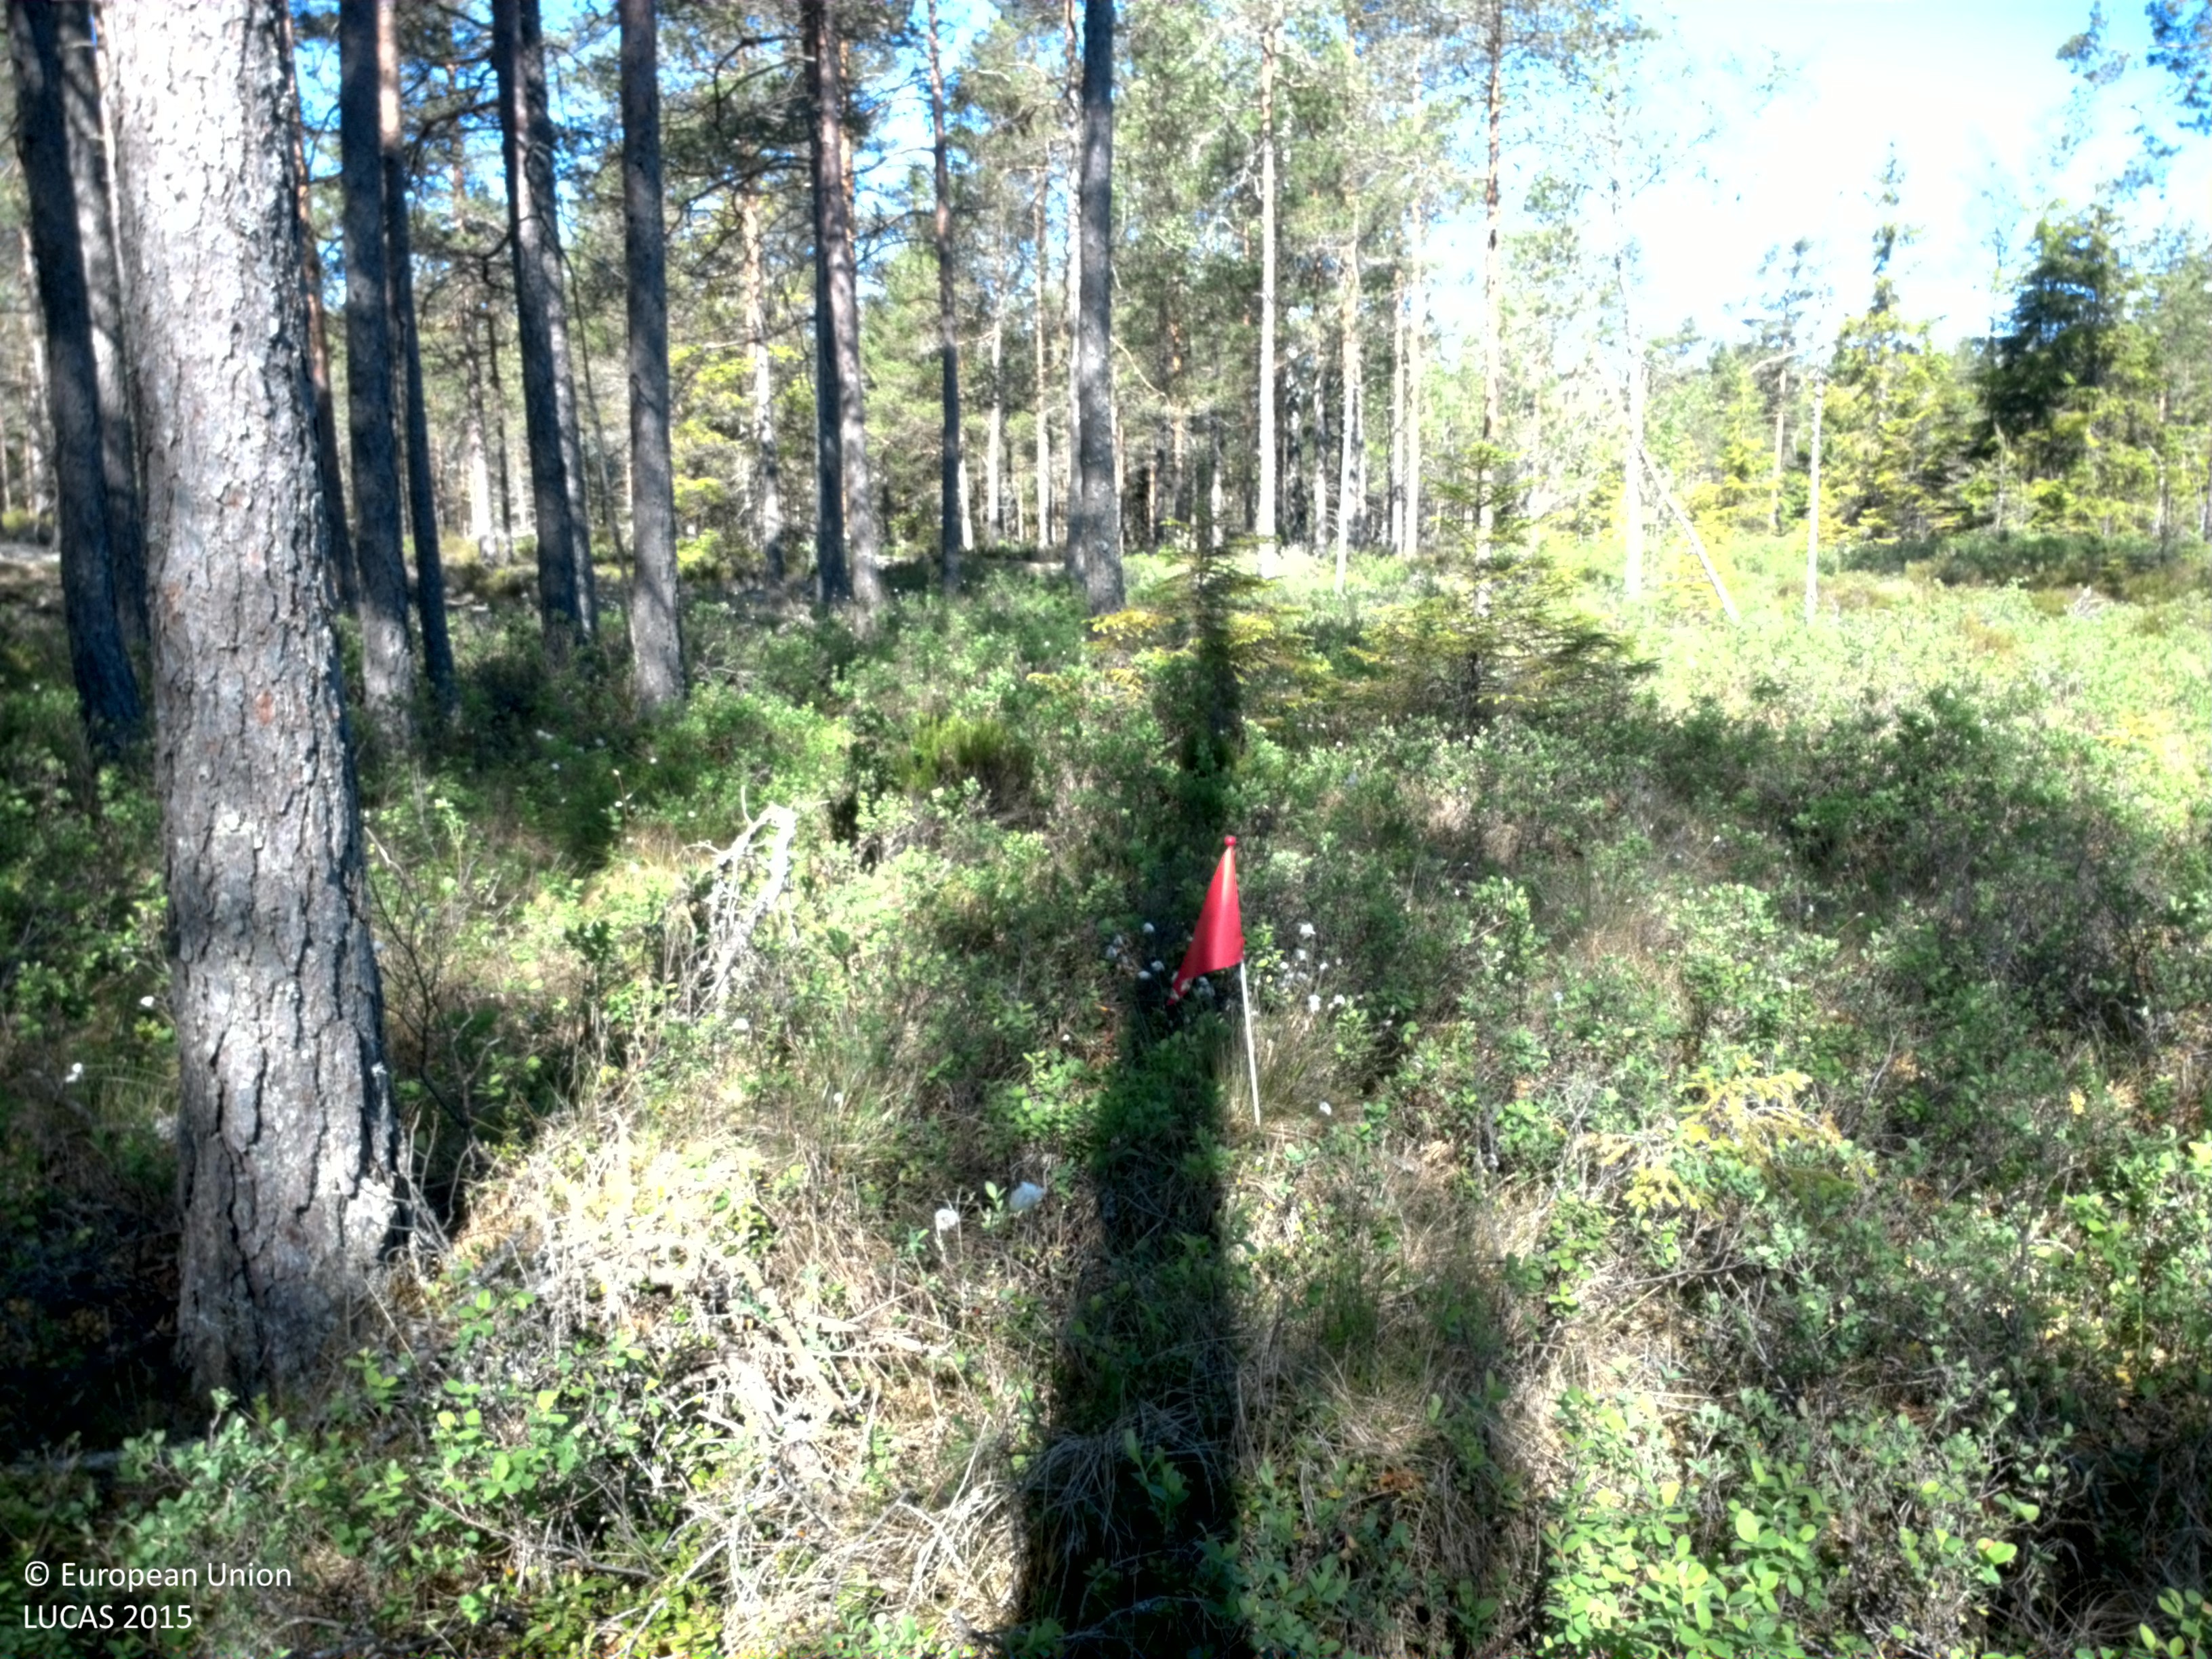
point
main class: Woodland
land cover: Pine dominated coniferous woodland
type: boreal forest
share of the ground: 50 - 75 %
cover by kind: coniferous forest trees 50 %, shrubs 25 %, herbaceous plants 10 %, lichens and mosses 10 %, broadleaved forest trees 5 %
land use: Forestry
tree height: > 5 m
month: June
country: SE
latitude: 59.4994
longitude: 12.0613
